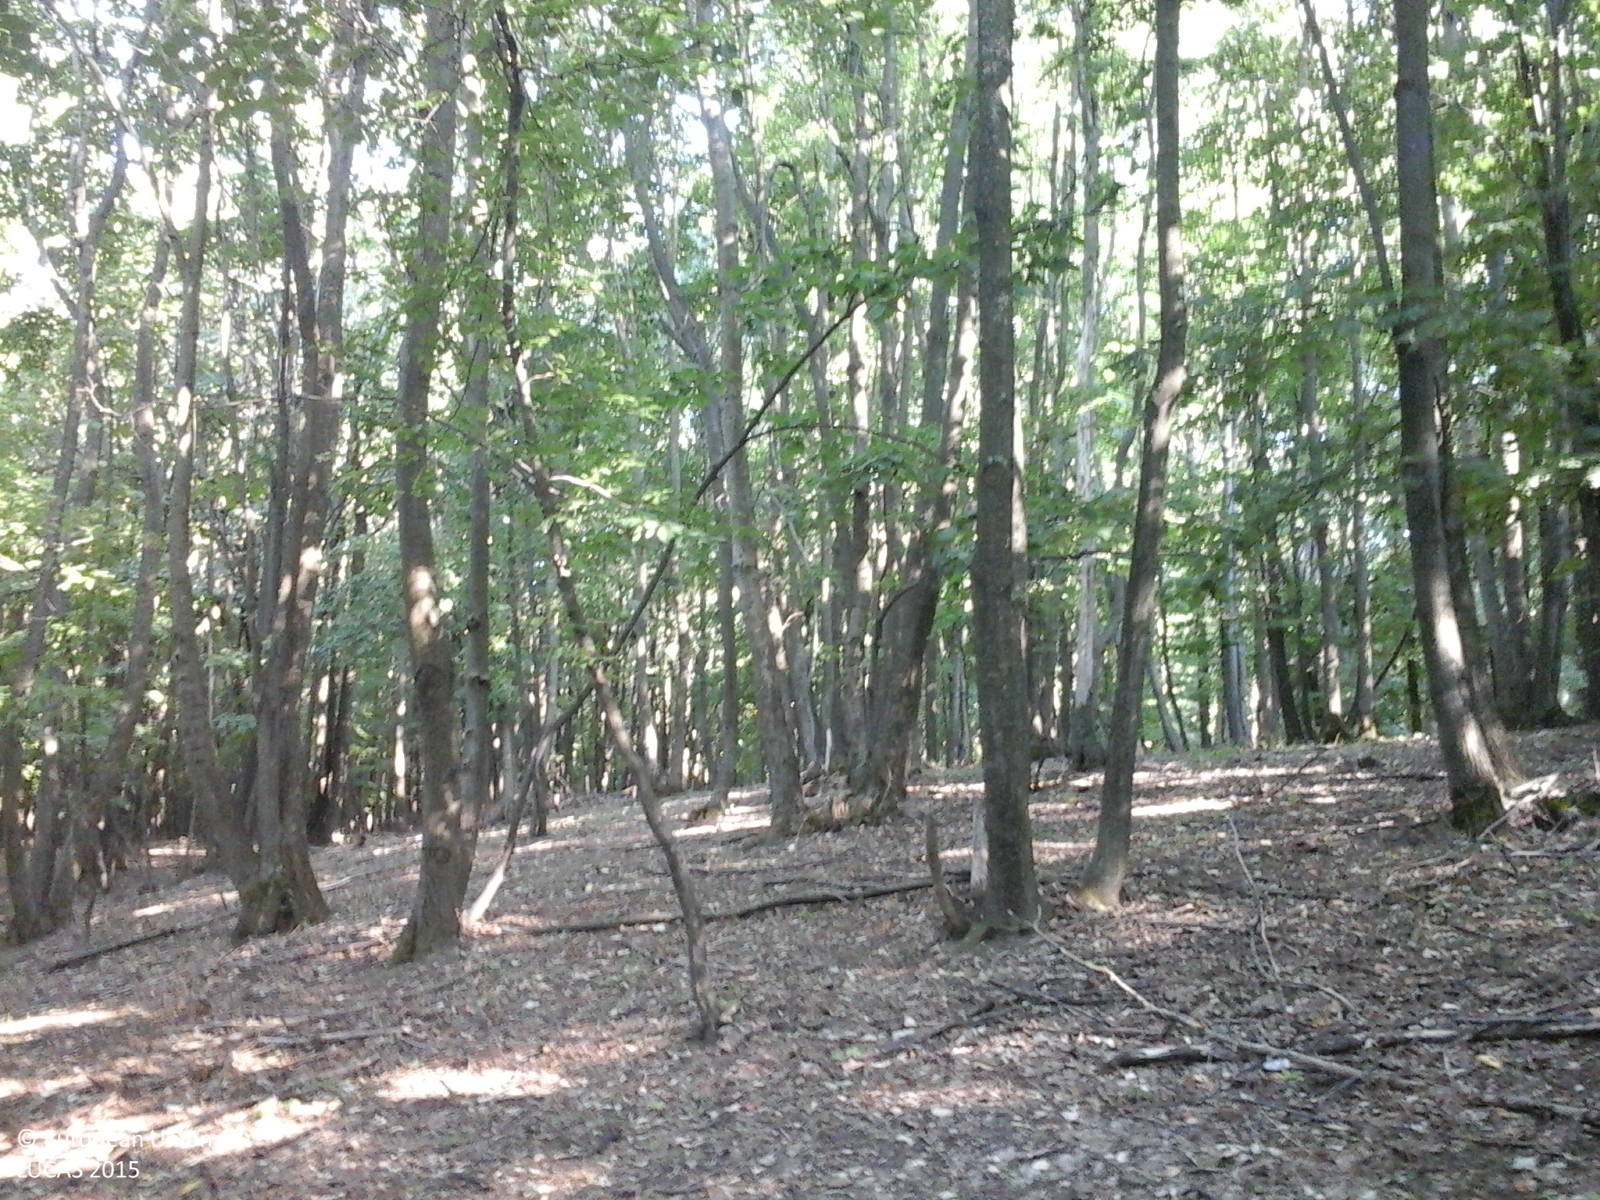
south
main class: Woodland
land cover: Broadleaved woodland
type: mesophytic deciduous forest
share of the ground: > 75 %
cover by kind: broadleaved forest trees 100 %
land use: Forestry
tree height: > 5 m
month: June
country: RO
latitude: 46.9445
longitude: 27.9020
